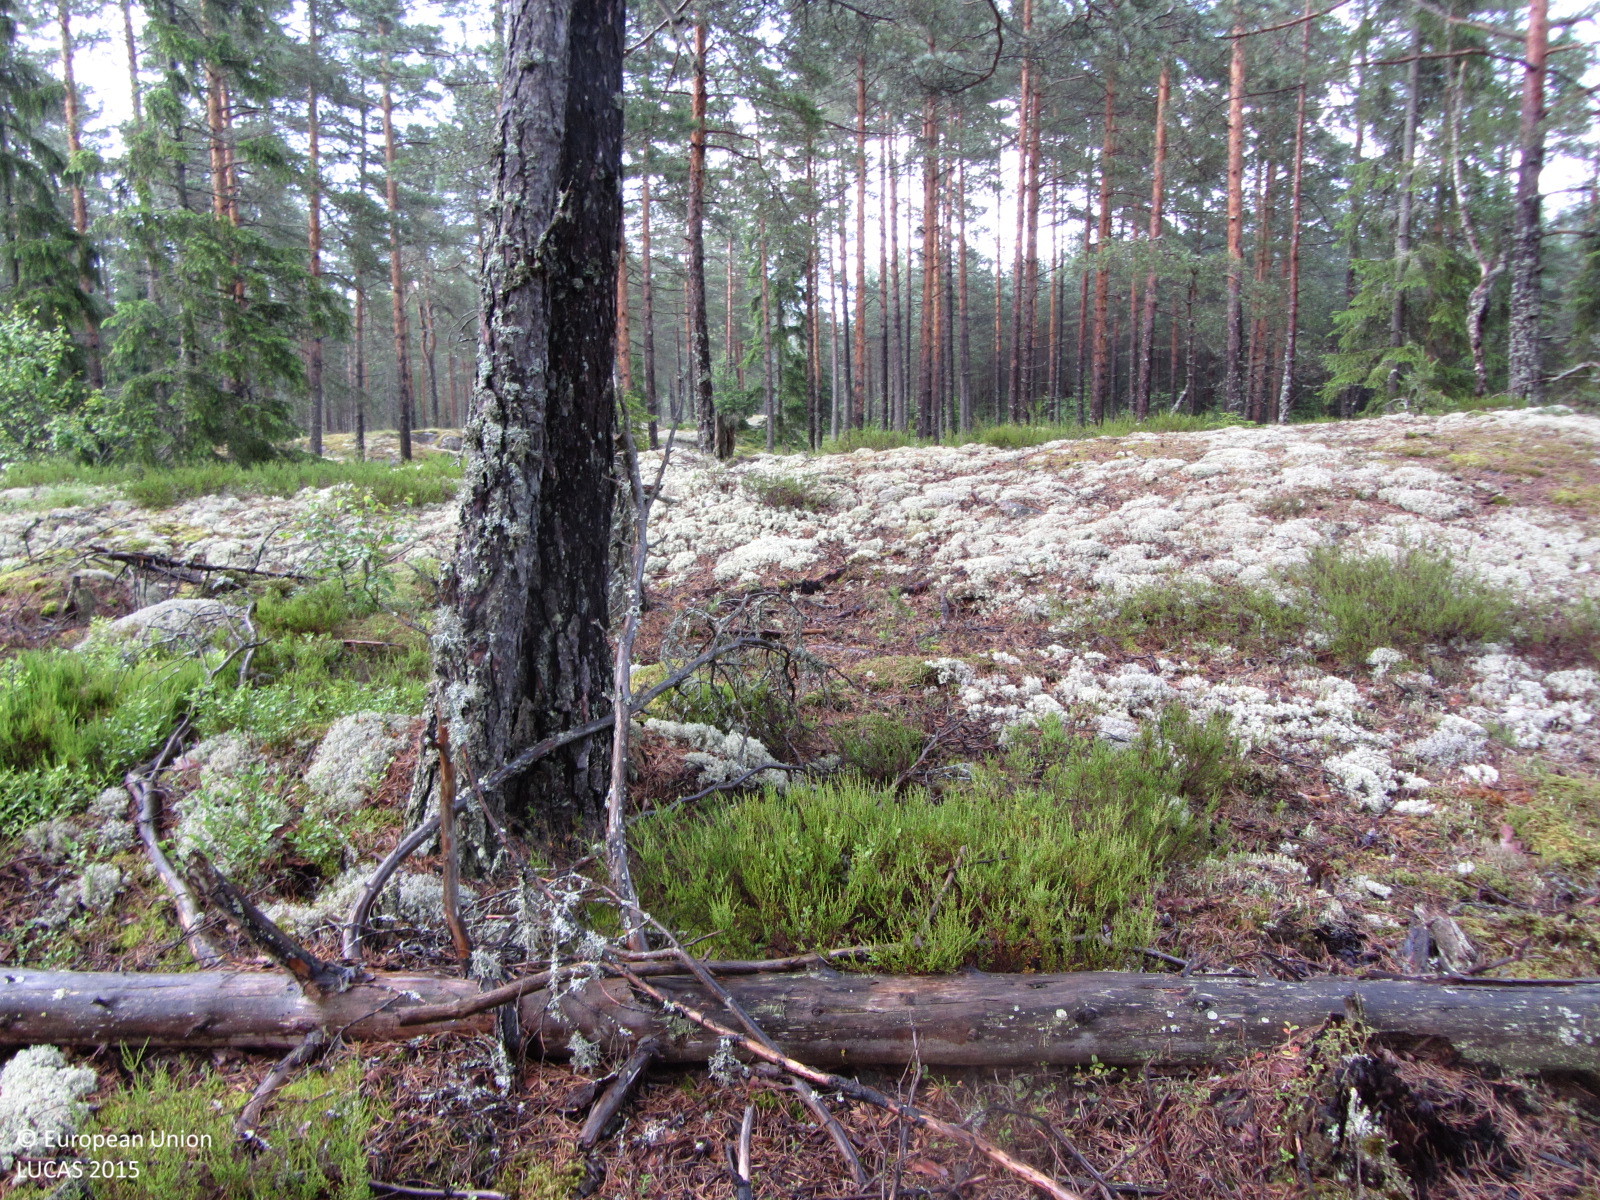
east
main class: Woodland
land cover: Pine dominated coniferous woodland
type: boreal forest
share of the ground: 50 - 75 %
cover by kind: coniferous forest trees 50 %, shrubs 30 %, lichens and mosses 20 %
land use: Forestry
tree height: > 5 m
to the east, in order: Pine dominated coniferous woodland; Other mixed woodland
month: July
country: FI
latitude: 60.0385
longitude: 23.1337
